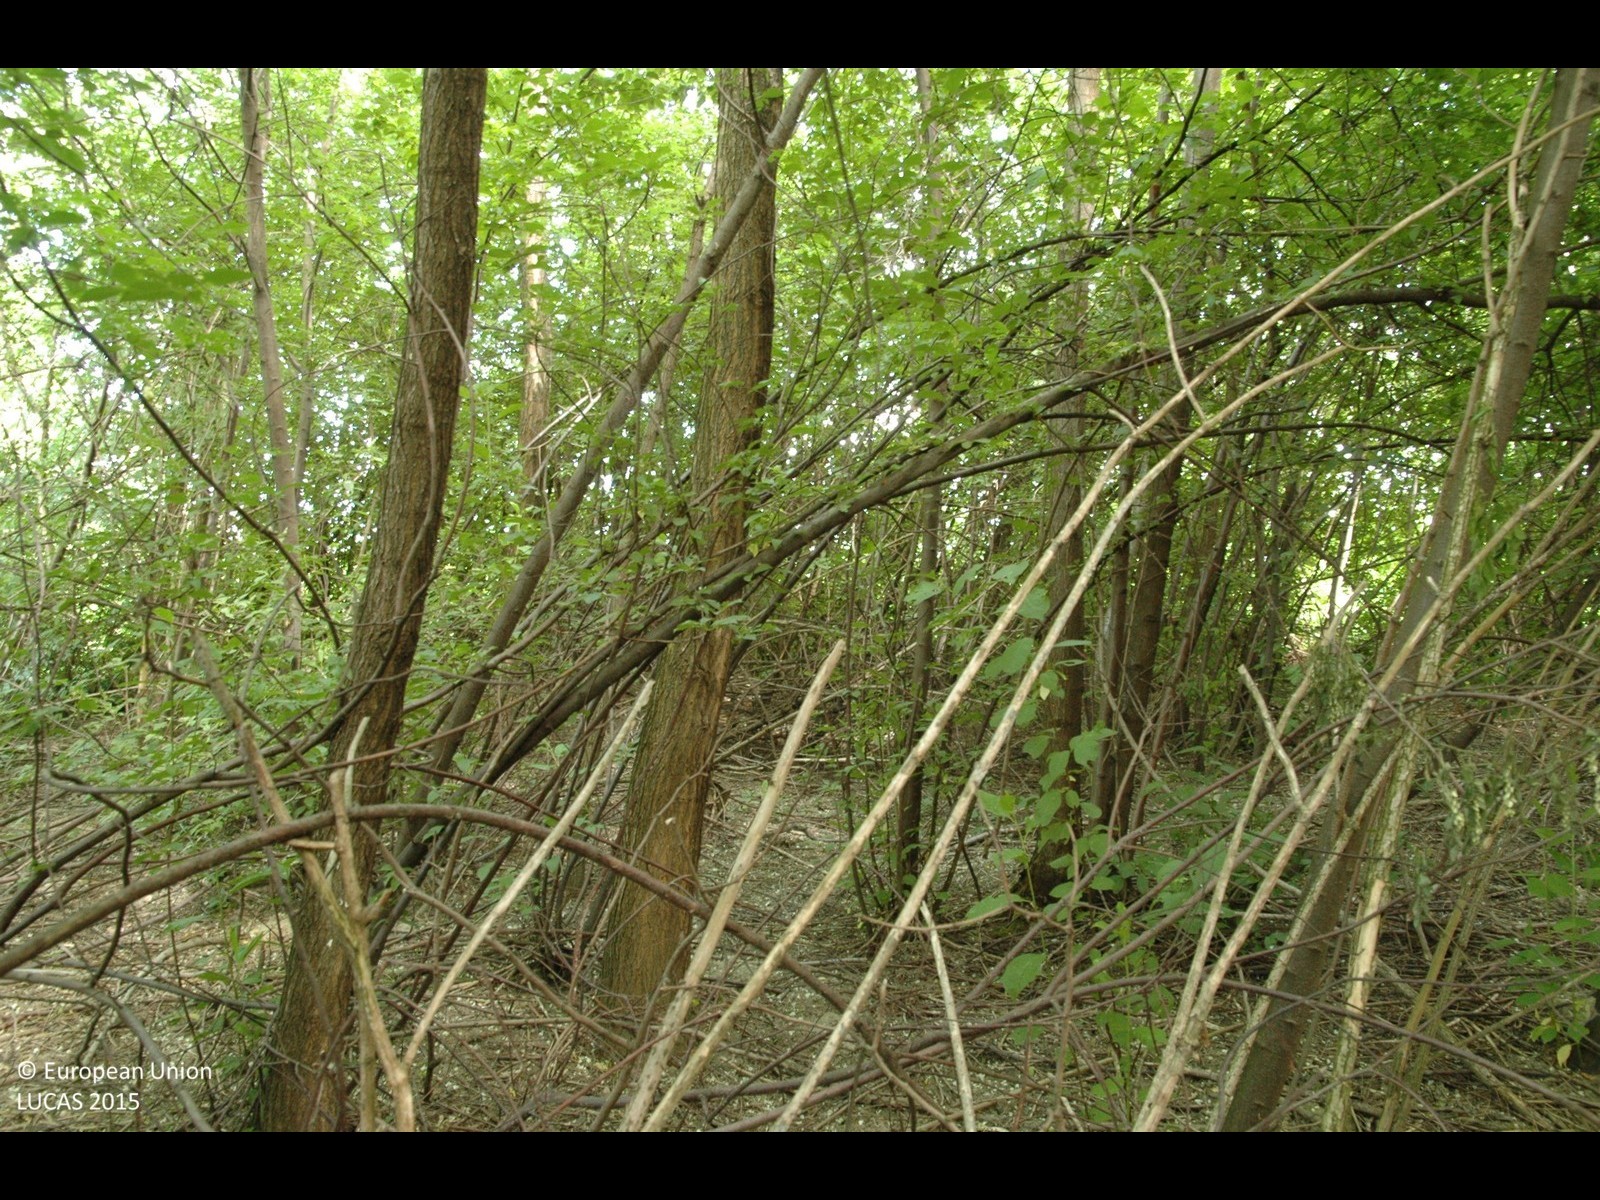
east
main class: Woodland
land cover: Broadleaved woodland
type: floodplain forest
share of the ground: > 75 %
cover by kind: broadleaved forest trees 90 %, shrubs 5 %, herbaceous plants 5 %
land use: Forestry
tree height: > 5 m
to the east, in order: Broadleaved woodland; Tracks; Spontaneously vegetated surfaces; Maize; Spontaneously vegetated surfaces; Grassland without tree/shrub cover; Maize; Common wheat; Maize; Tracks; Grassland without tree/shrub cover; Nuts trees
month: May
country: HR
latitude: 46.3024
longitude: 16.4271
